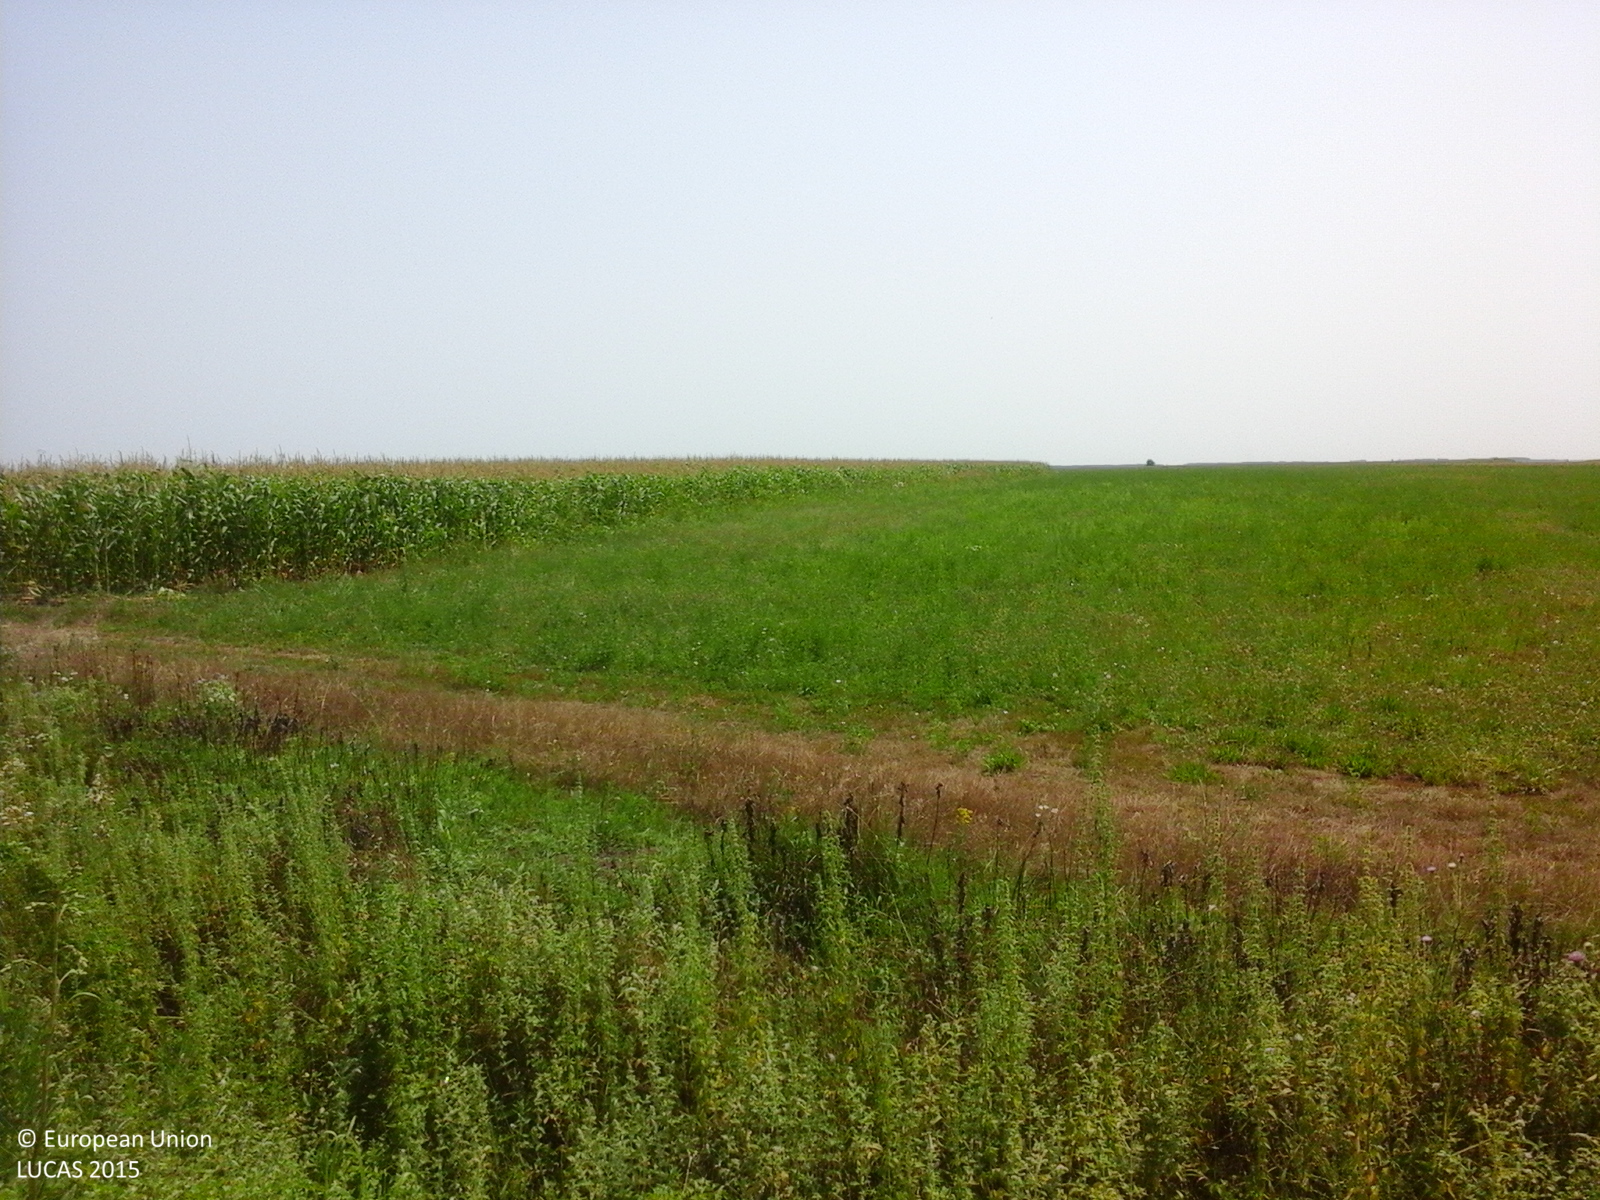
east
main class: Cropland
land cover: Lucerne
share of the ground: 50 - 75 %
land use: Agriculture (excluding fallow land and kitchen gardens)
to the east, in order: Grass margins; Ditches and canals; Grass margins; Tracks; Lucerne; Maize; Grassland without tree/shrub cover
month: July
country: RO
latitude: 44.6172
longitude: 26.6162
